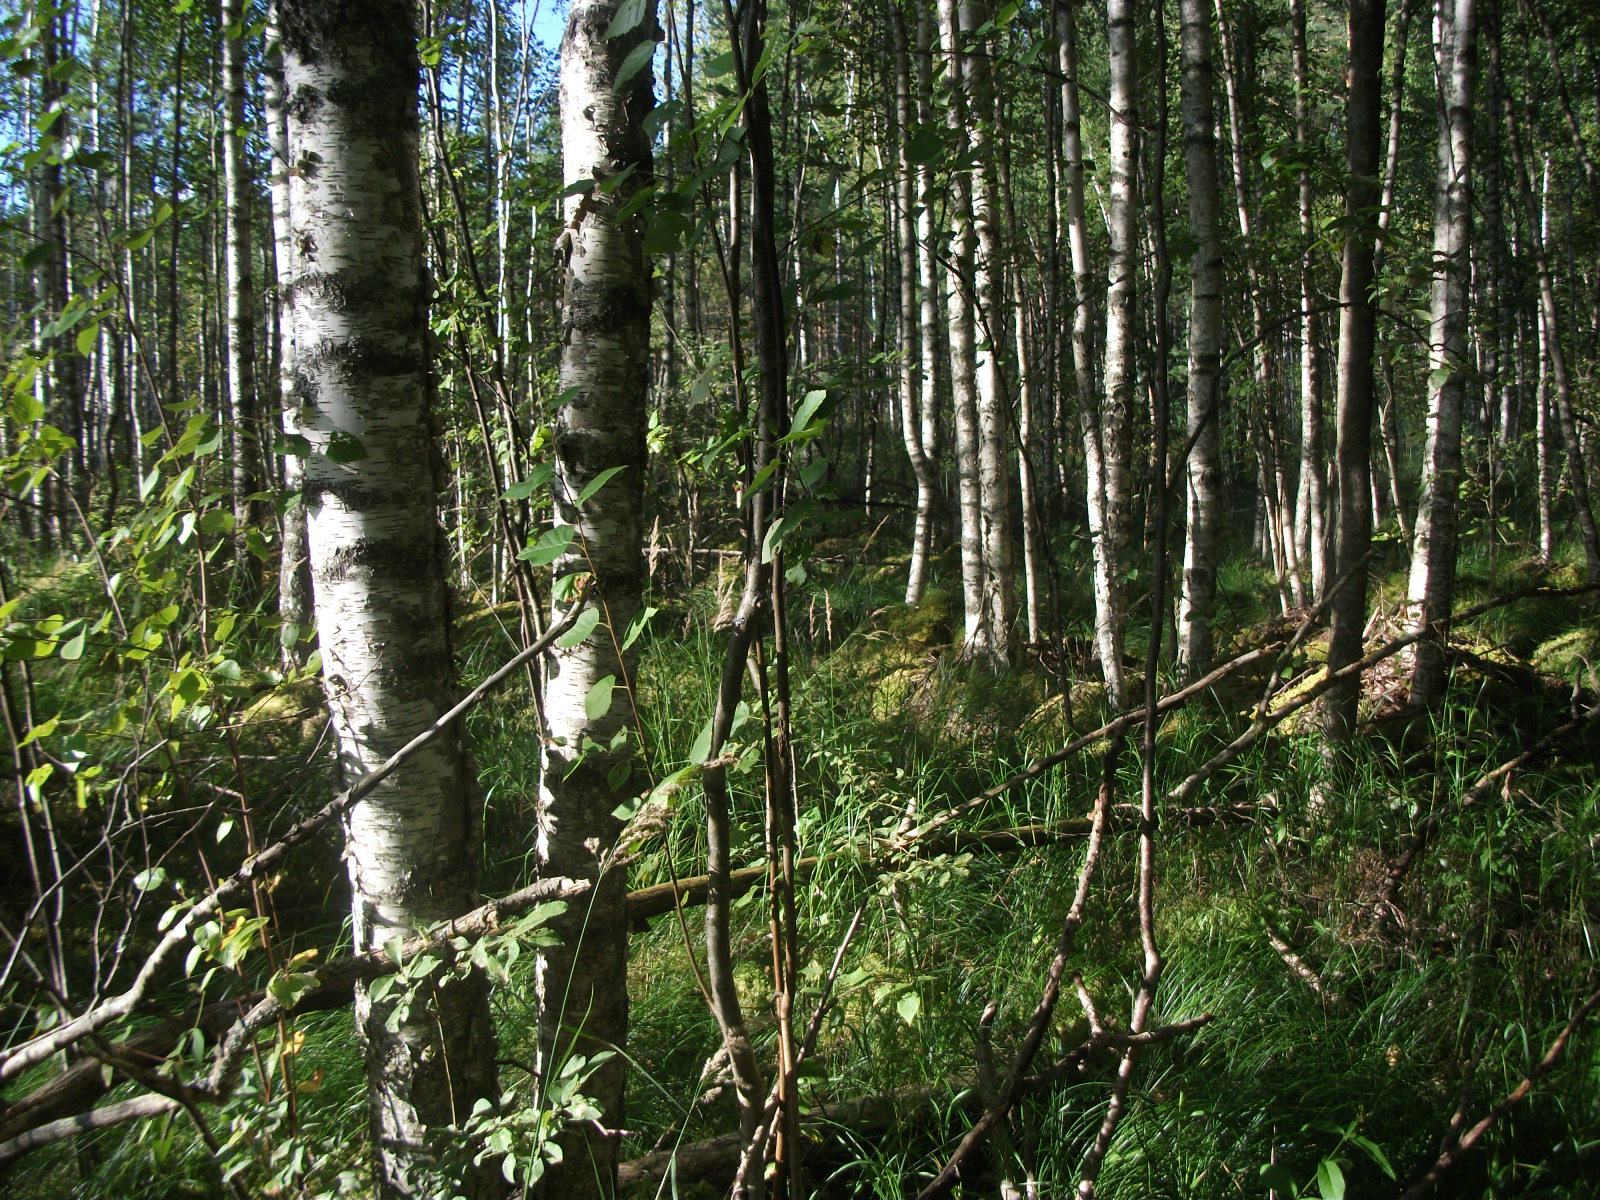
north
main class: Woodland
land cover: Broadleaved woodland
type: mire and swamp forests
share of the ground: > 75 %
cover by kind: broadleaved forest trees 85 %, lichens and mosses 10 %, herbaceous plants 5 %
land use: Forestry
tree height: > 5 m
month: August
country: LV
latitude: 56.5181
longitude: 26.4146
